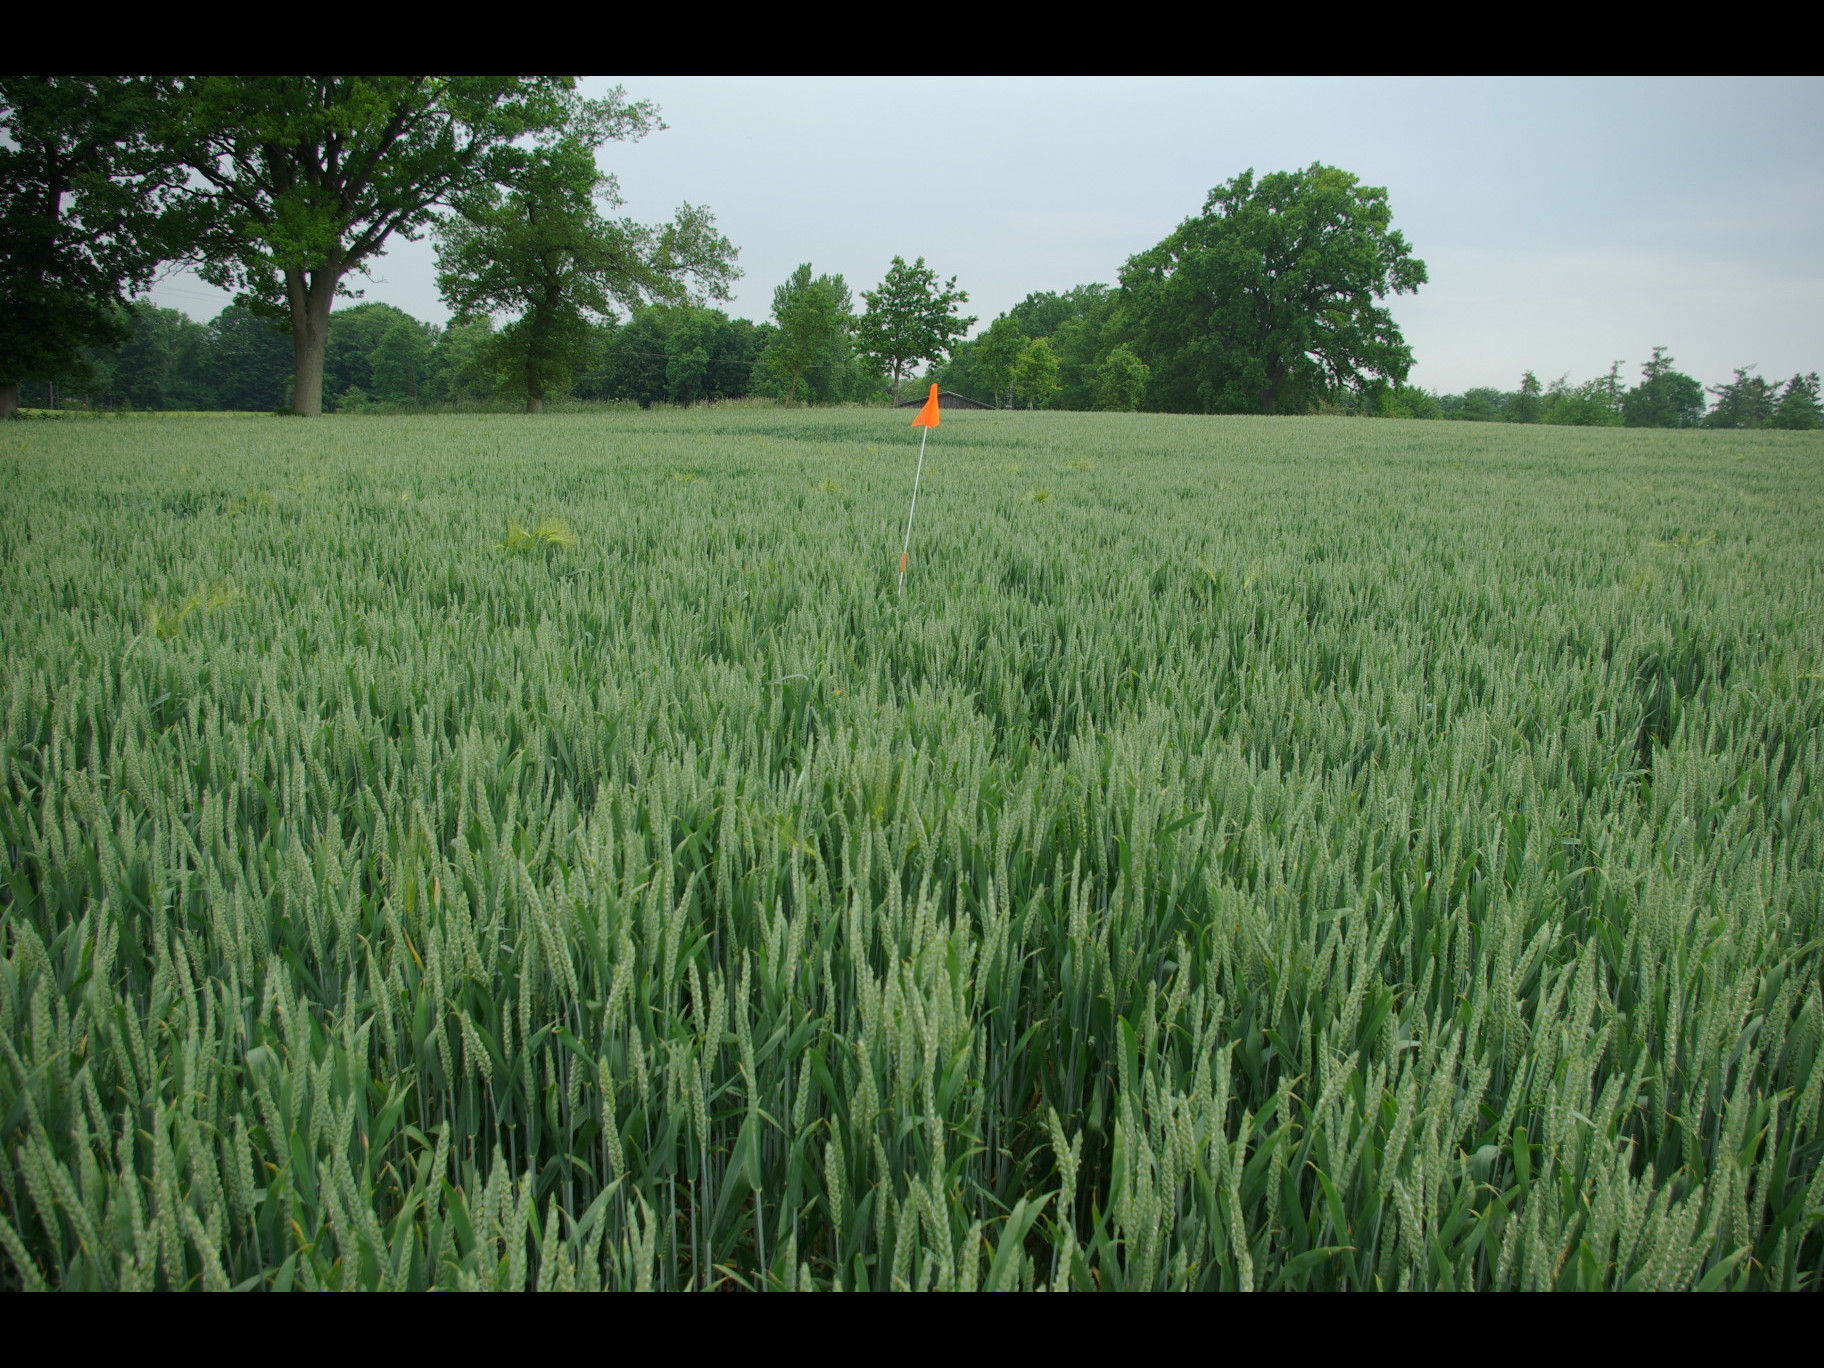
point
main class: Cropland
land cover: Common wheat
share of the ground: > 75 %
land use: Agriculture (excluding fallow land and kitchen gardens)
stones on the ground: 10 - 25 %
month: June
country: DE
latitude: 54.4443
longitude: 9.9538
